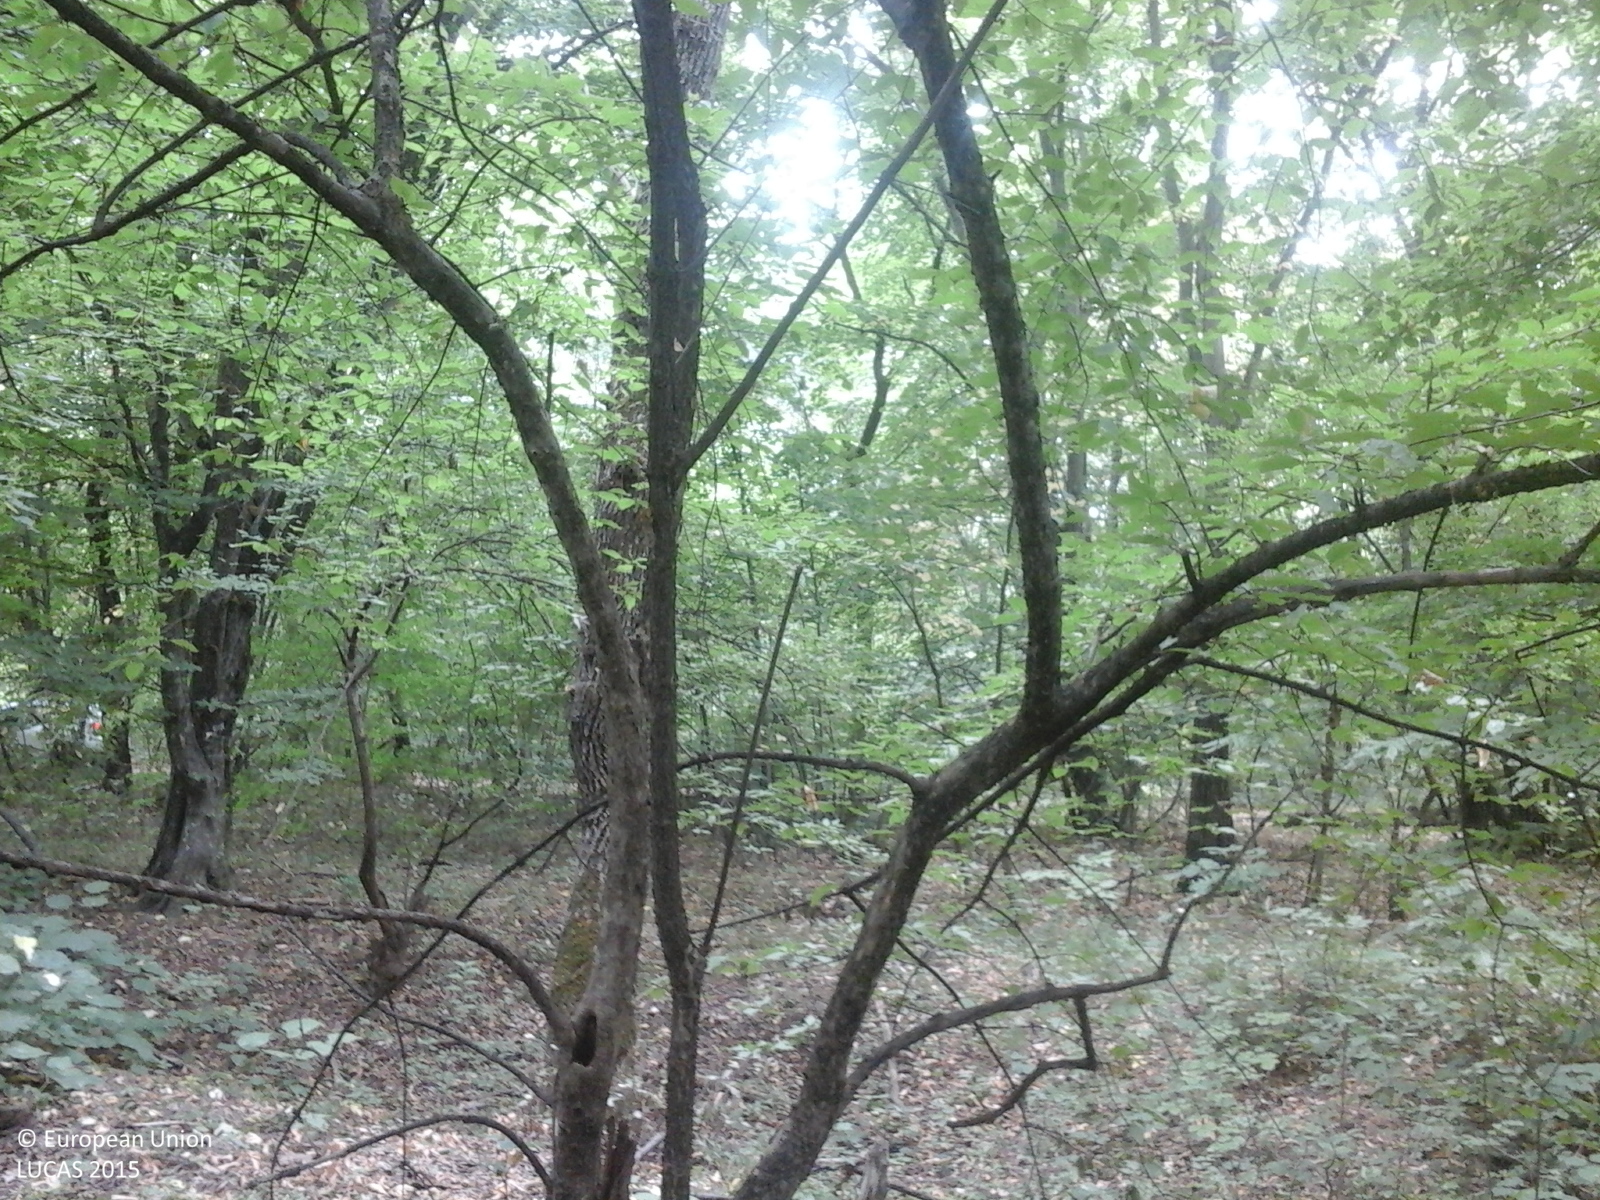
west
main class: Woodland
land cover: Broadleaved woodland
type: mesophytic deciduous forest
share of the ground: > 75 %
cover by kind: broadleaved forest trees 100 %
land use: Forestry
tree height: > 5 m
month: July
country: RO
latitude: 45.2559
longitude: 28.3881
